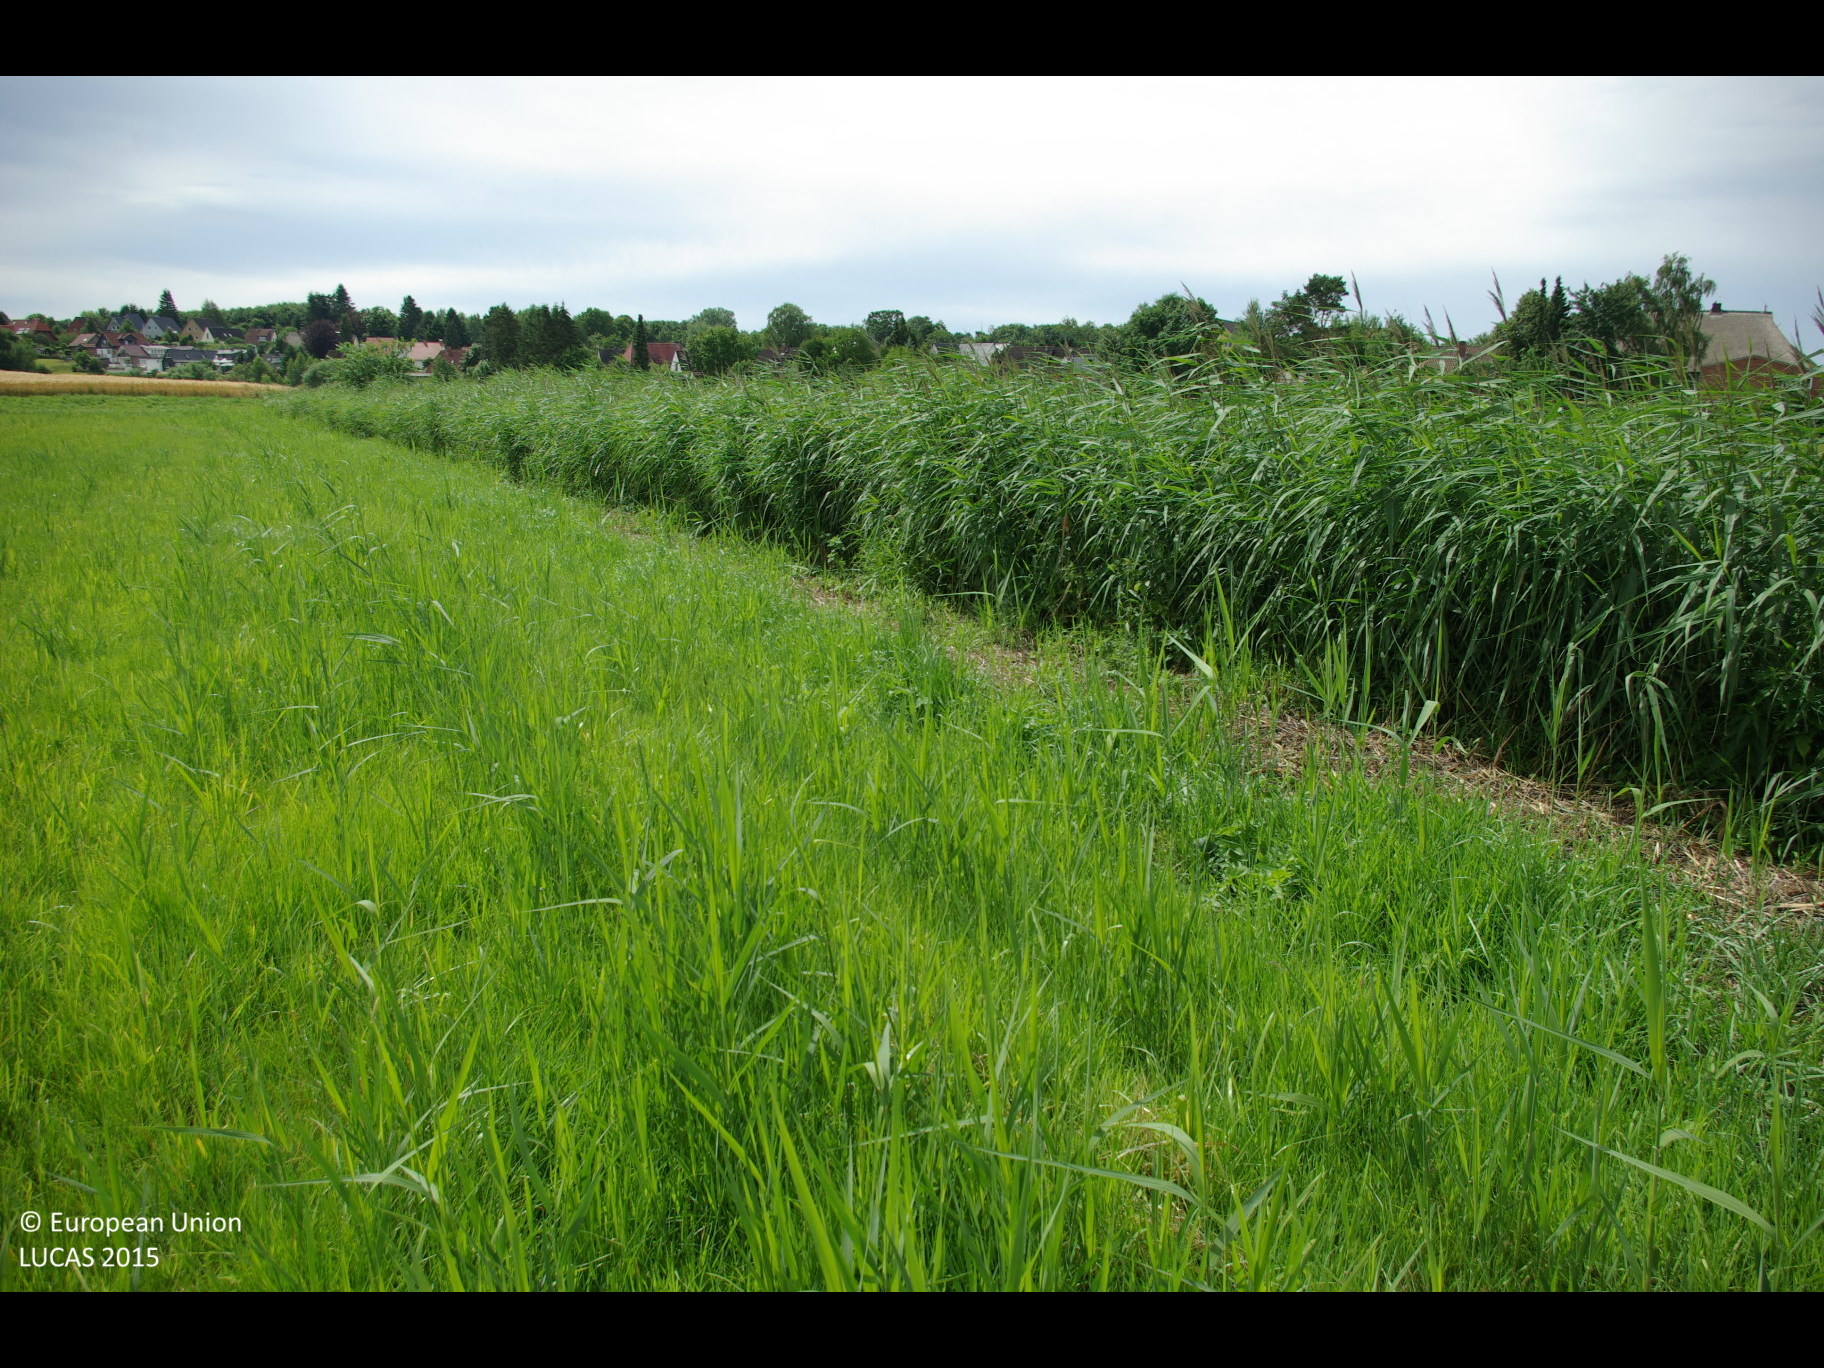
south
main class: Grassland
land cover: Grassland without tree/shrub cover
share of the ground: > 75 %
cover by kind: herbaceous plants 100 %
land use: Agriculture (excluding fallow land and kitchen gardens)
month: July
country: DE
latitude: 54.1551
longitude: 10.6274
